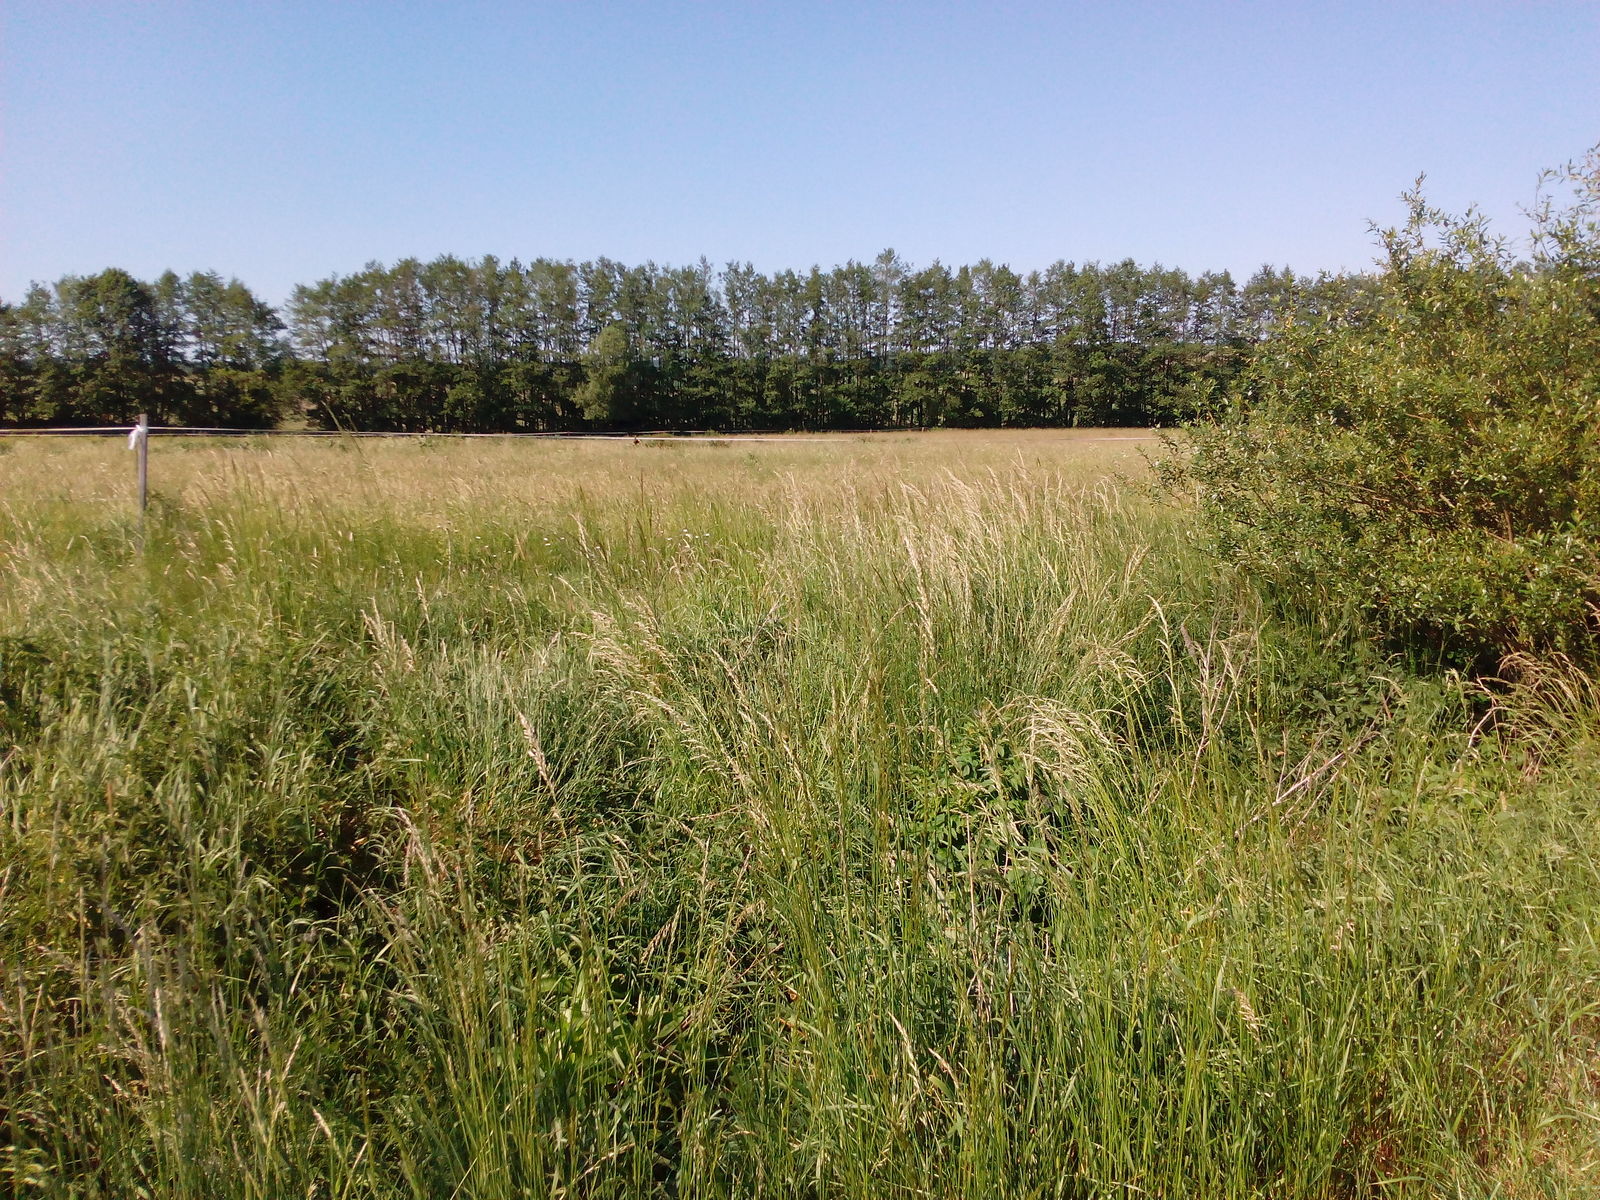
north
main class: Cropland
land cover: Common wheat
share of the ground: > 75 %
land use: Agriculture (excluding fallow land and kitchen gardens)
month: June
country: DE
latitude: 50.3803
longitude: 10.6326
